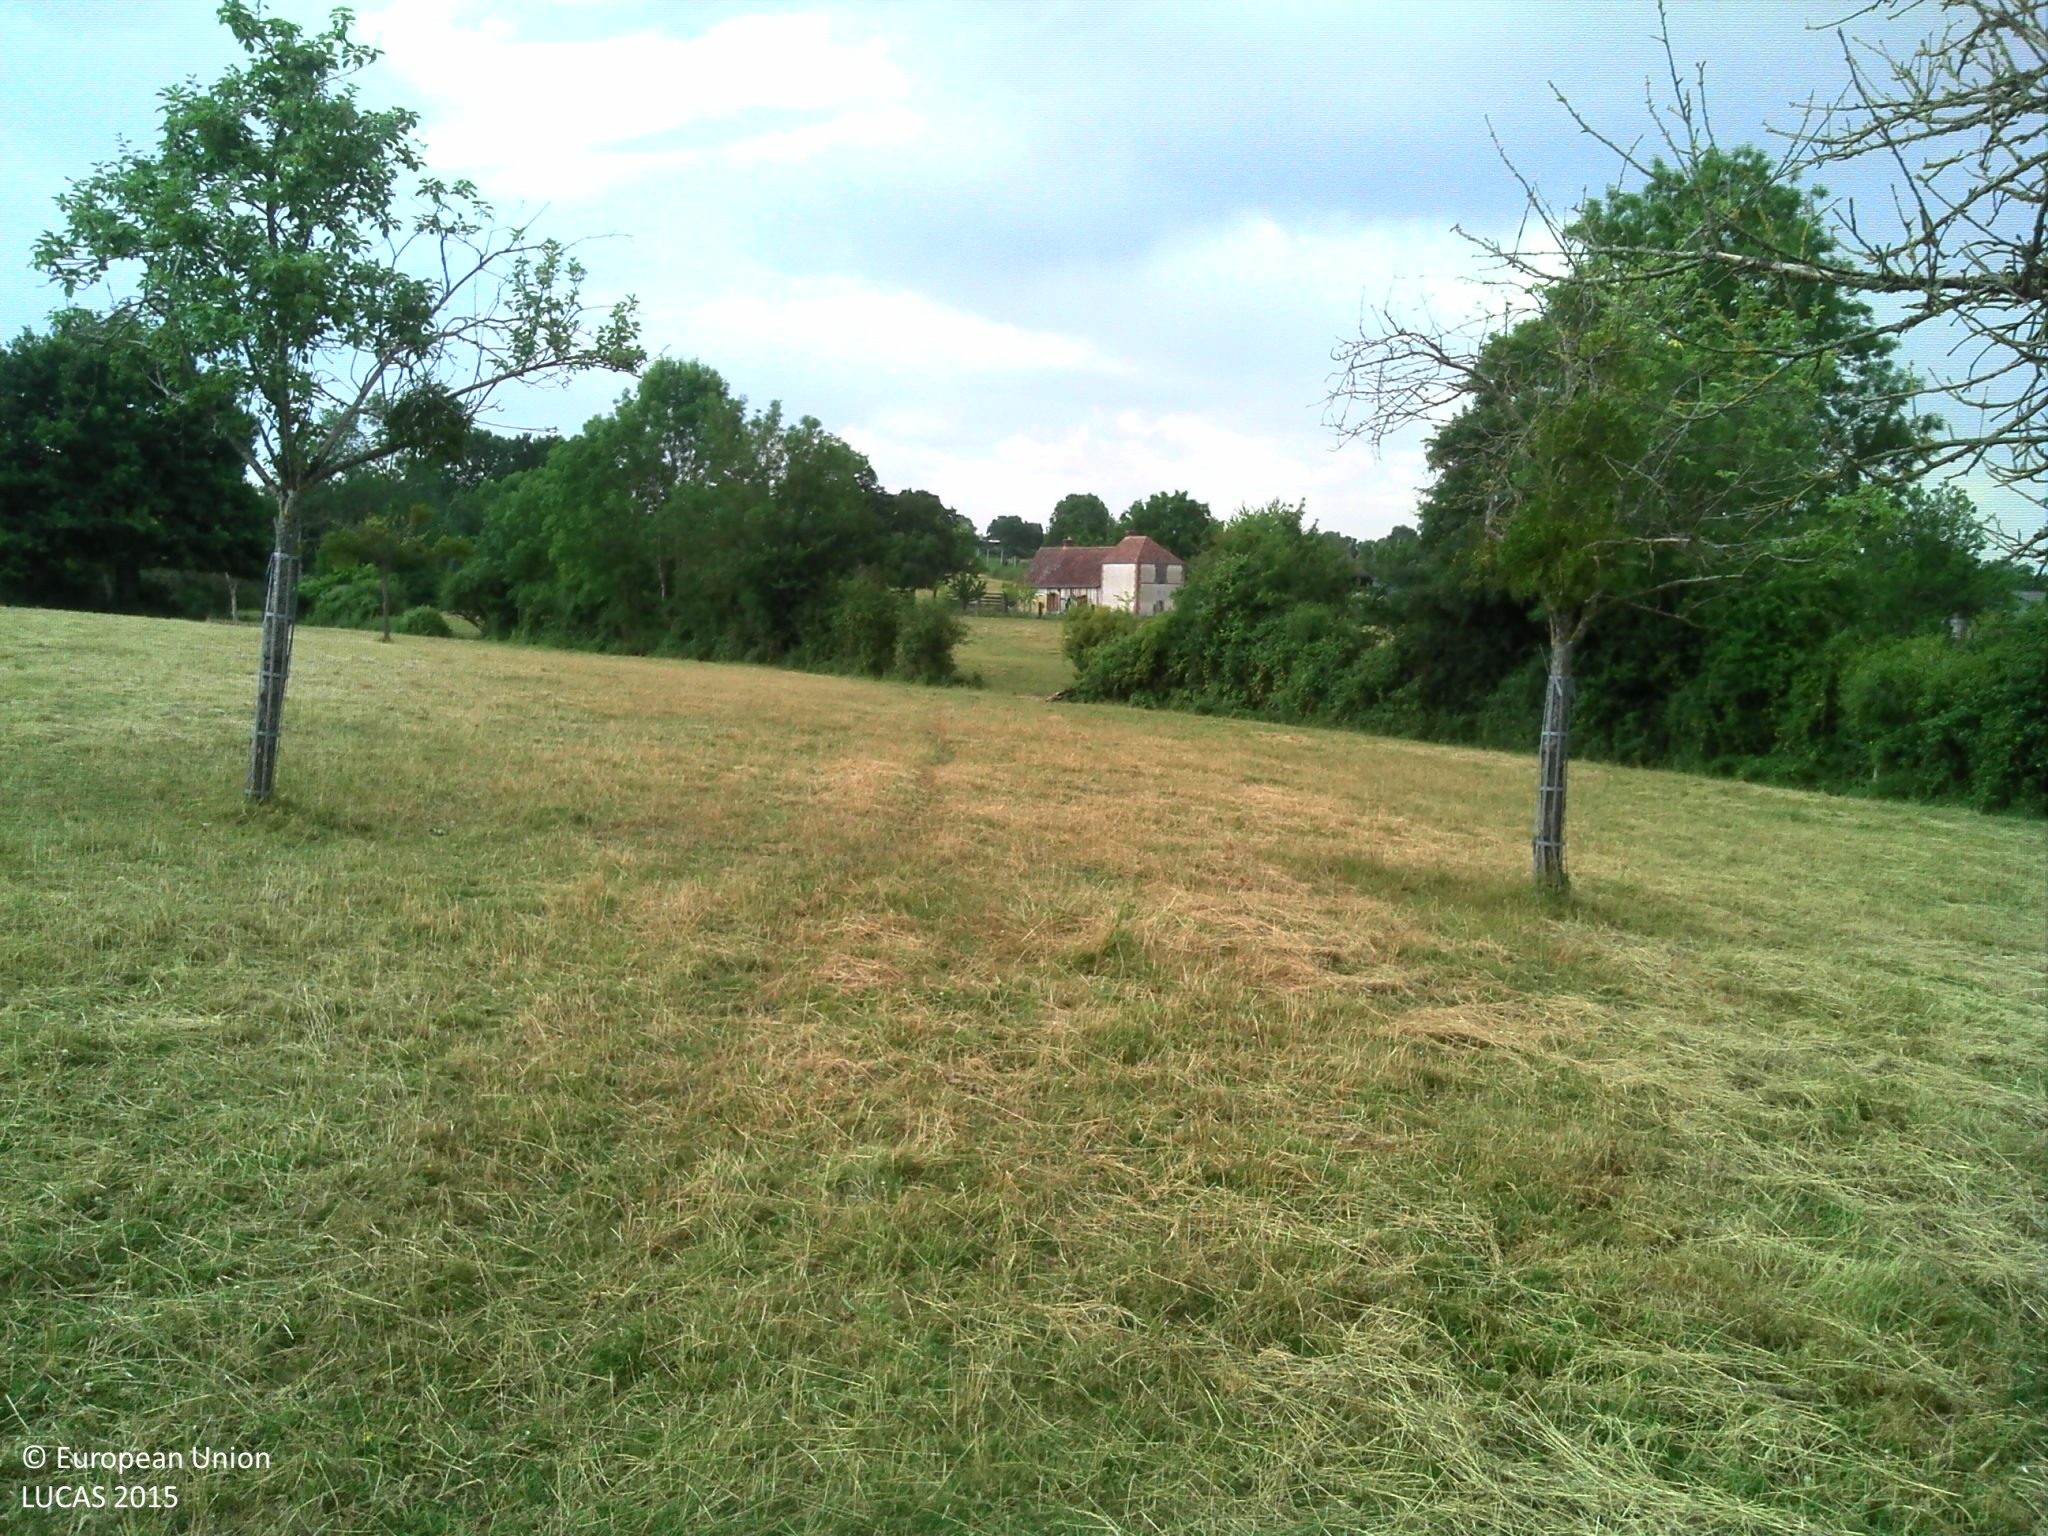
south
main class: Cropland
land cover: Apple fruit
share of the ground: 10 - 25 %
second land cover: Grassland without tree/shrub cover
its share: > 75 %
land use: Agriculture (excluding fallow land and kitchen gardens)
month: July
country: FR
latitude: 48.9499
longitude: 0.0425
